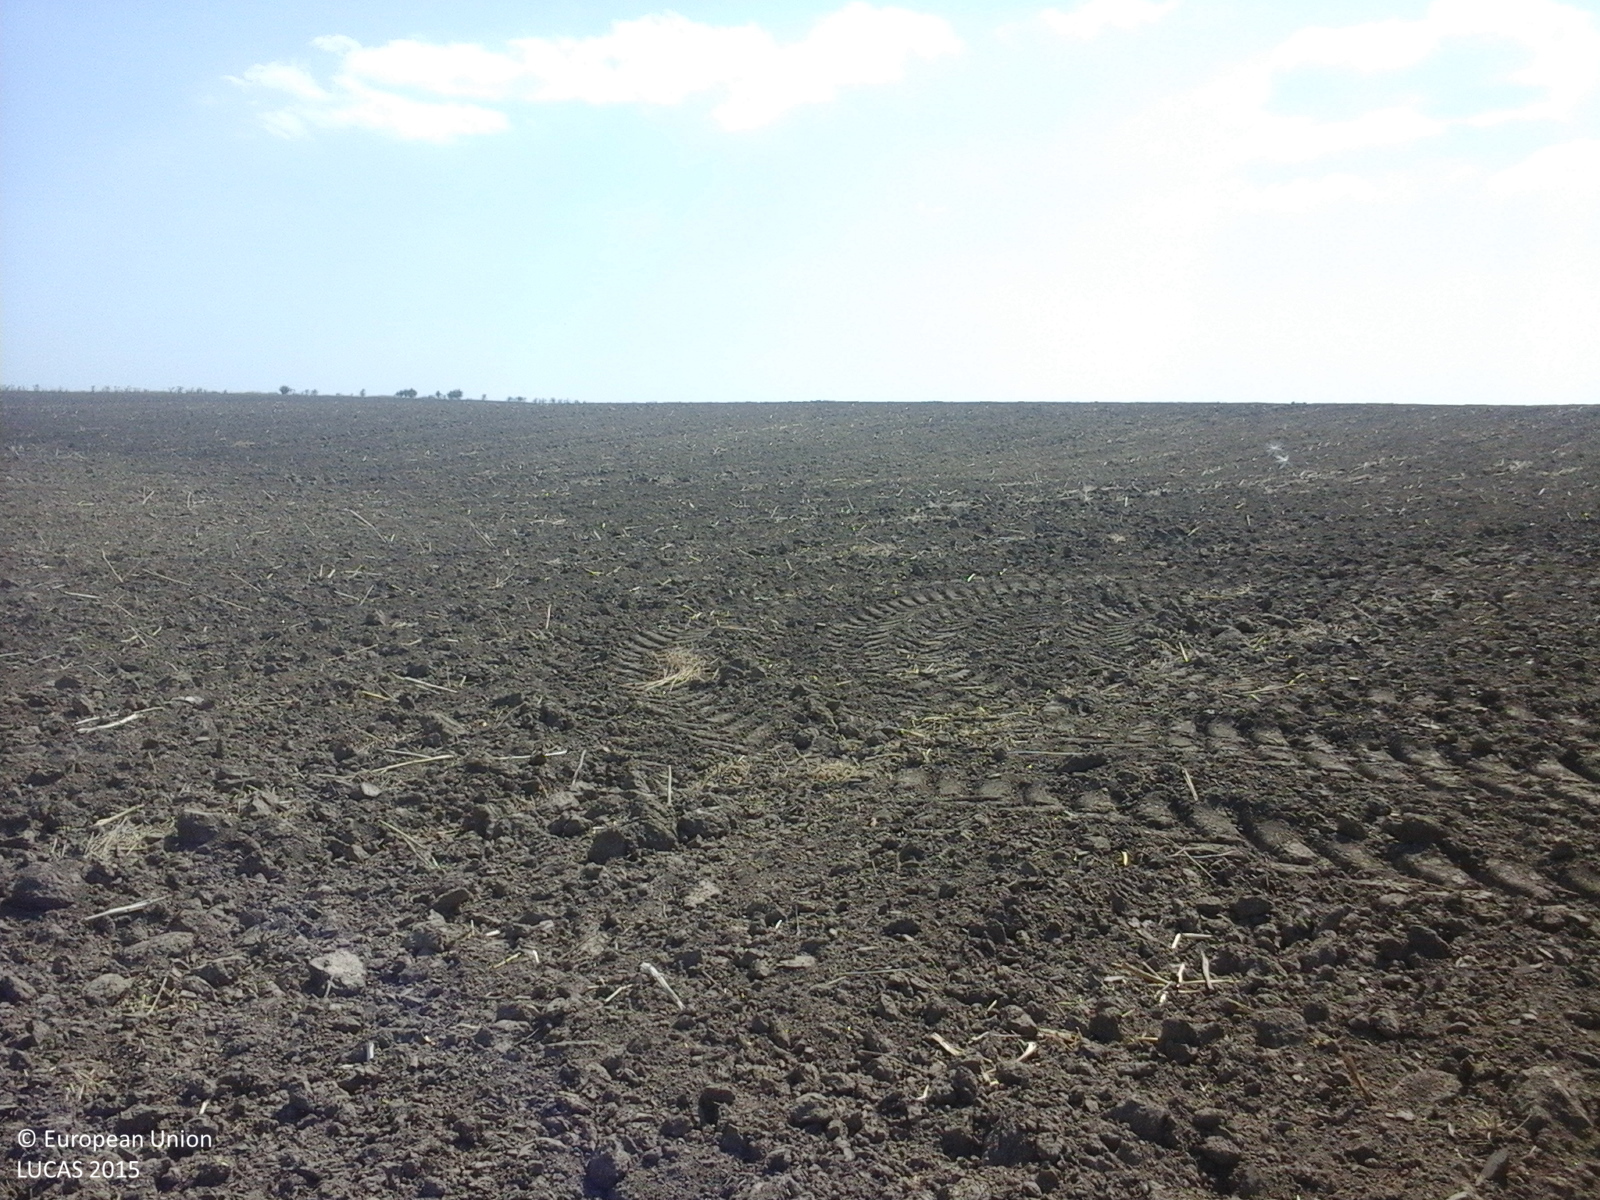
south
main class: Cropland
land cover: Rape and turnip rape
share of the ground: < 10 %
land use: Agriculture (excluding fallow land and kitchen gardens)
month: August
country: RO
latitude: 44.5549
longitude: 28.0747
